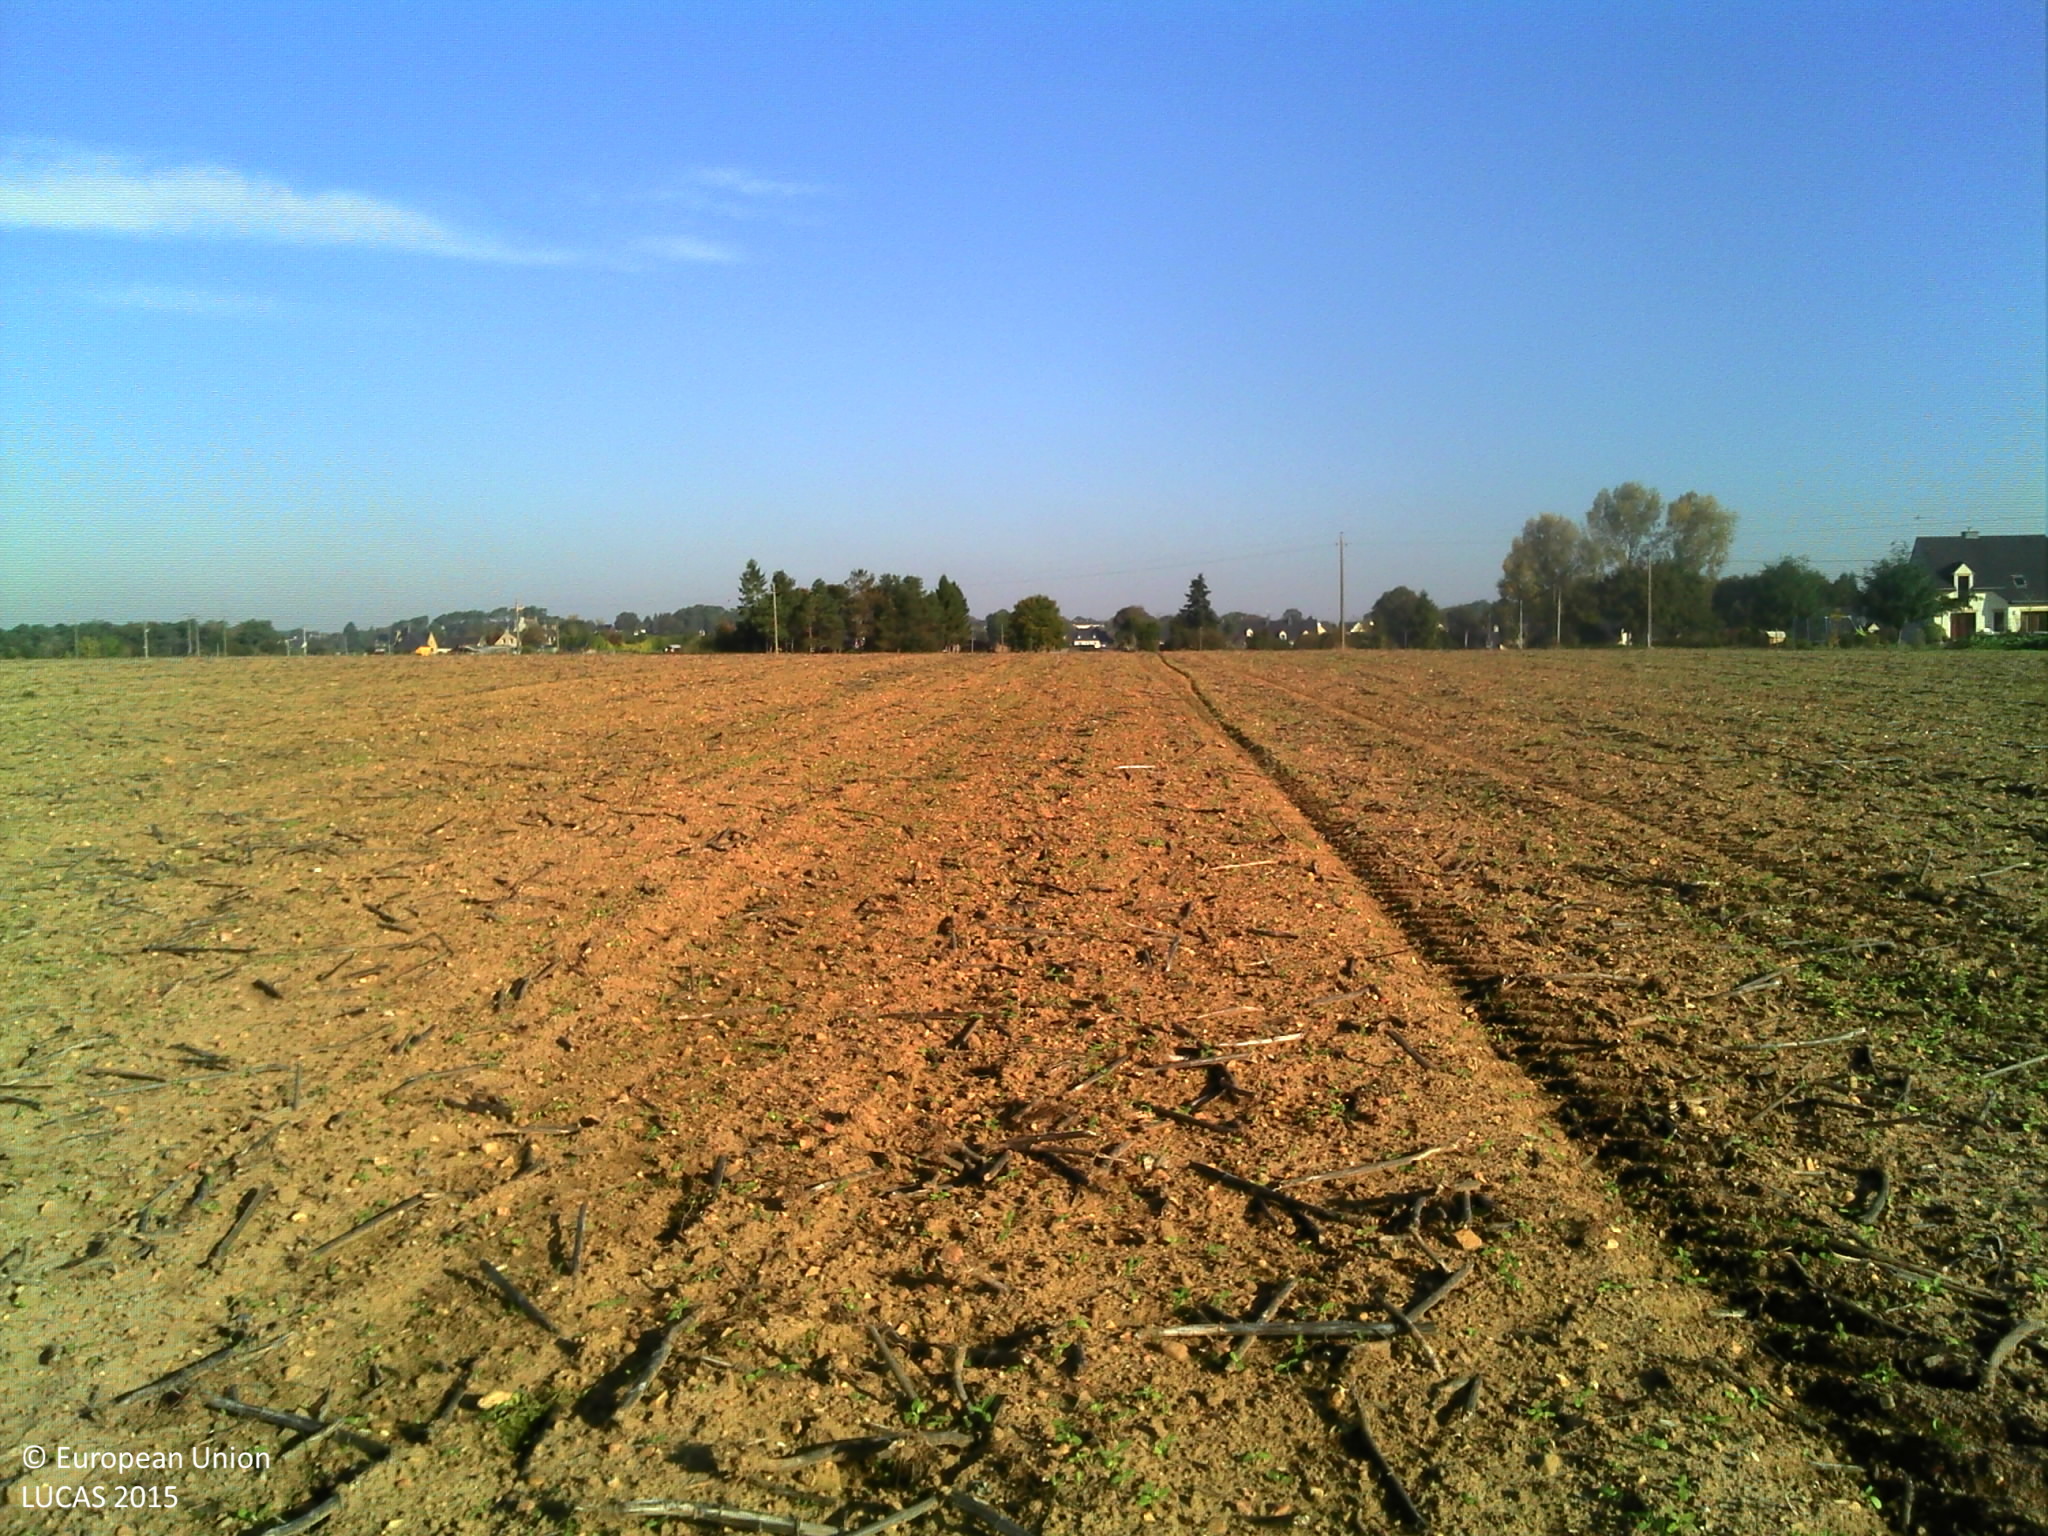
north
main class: Cropland
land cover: Sunflower
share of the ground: < 10 %
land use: Agriculture (excluding fallow land and kitchen gardens)
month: October
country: FR
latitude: 47.5892
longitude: -2.1127
